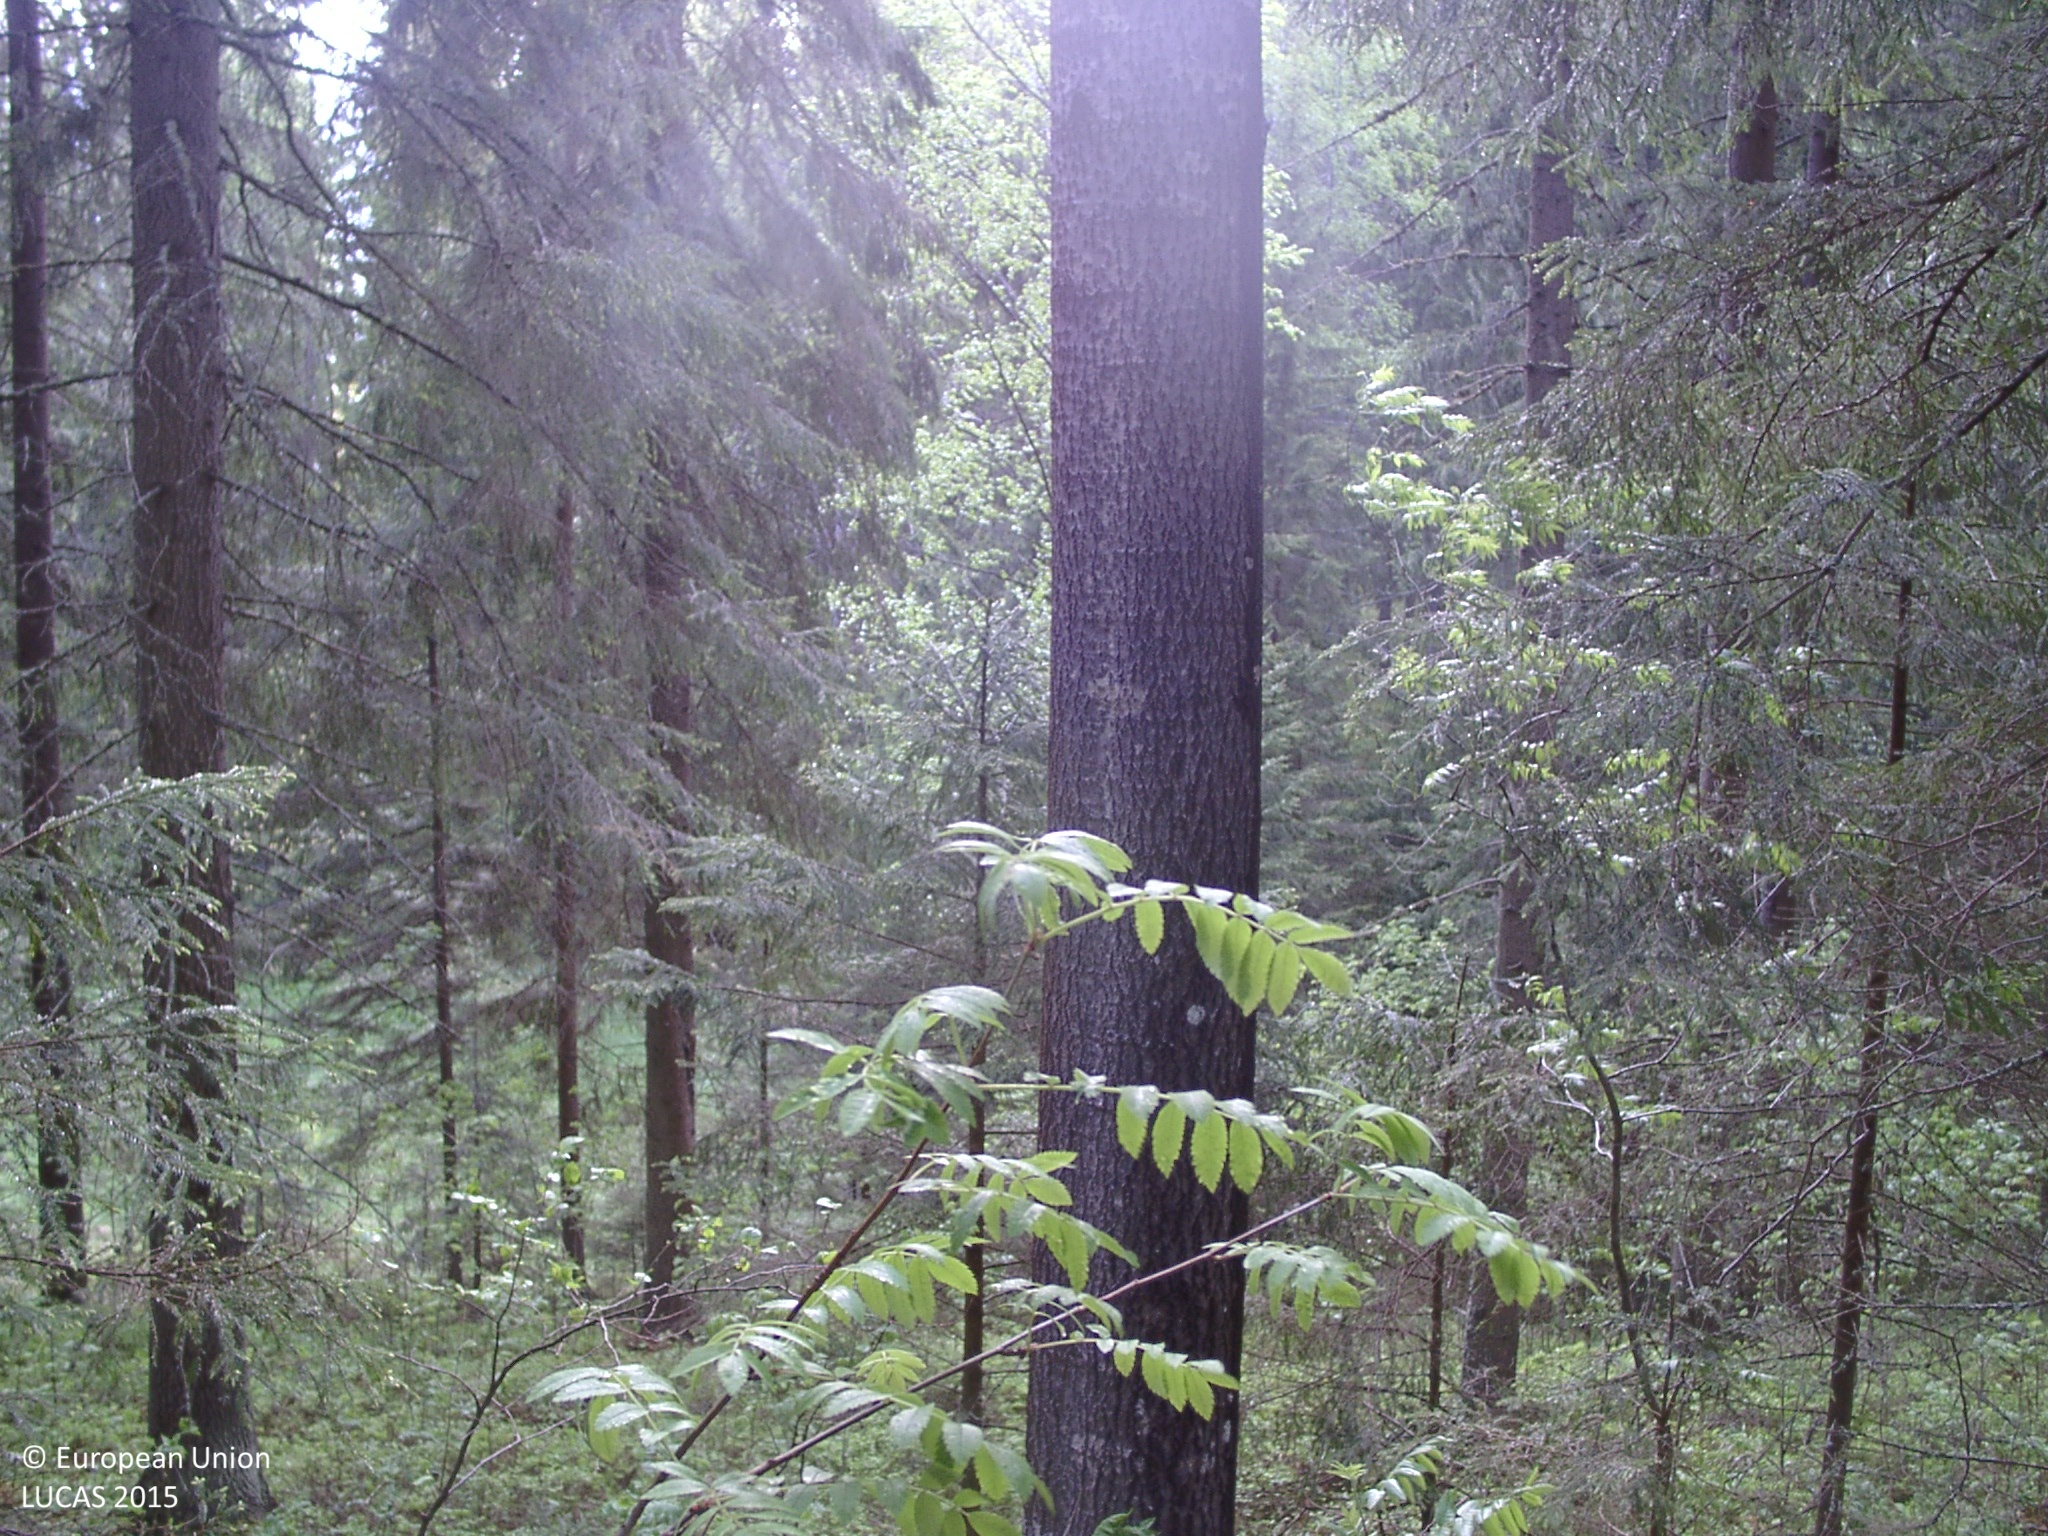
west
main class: Woodland
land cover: Spruce dominated coniferous woodland
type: boreal forest
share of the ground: 50 - 75 %
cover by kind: coniferous forest trees 65 %, shrubs 15 %, herbaceous plants 10 %, broadleaved forest trees 5 %, lichens and mosses 5 %
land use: Forestry
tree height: > 5 m
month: June
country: FI
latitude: 62.1891
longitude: 25.5045
